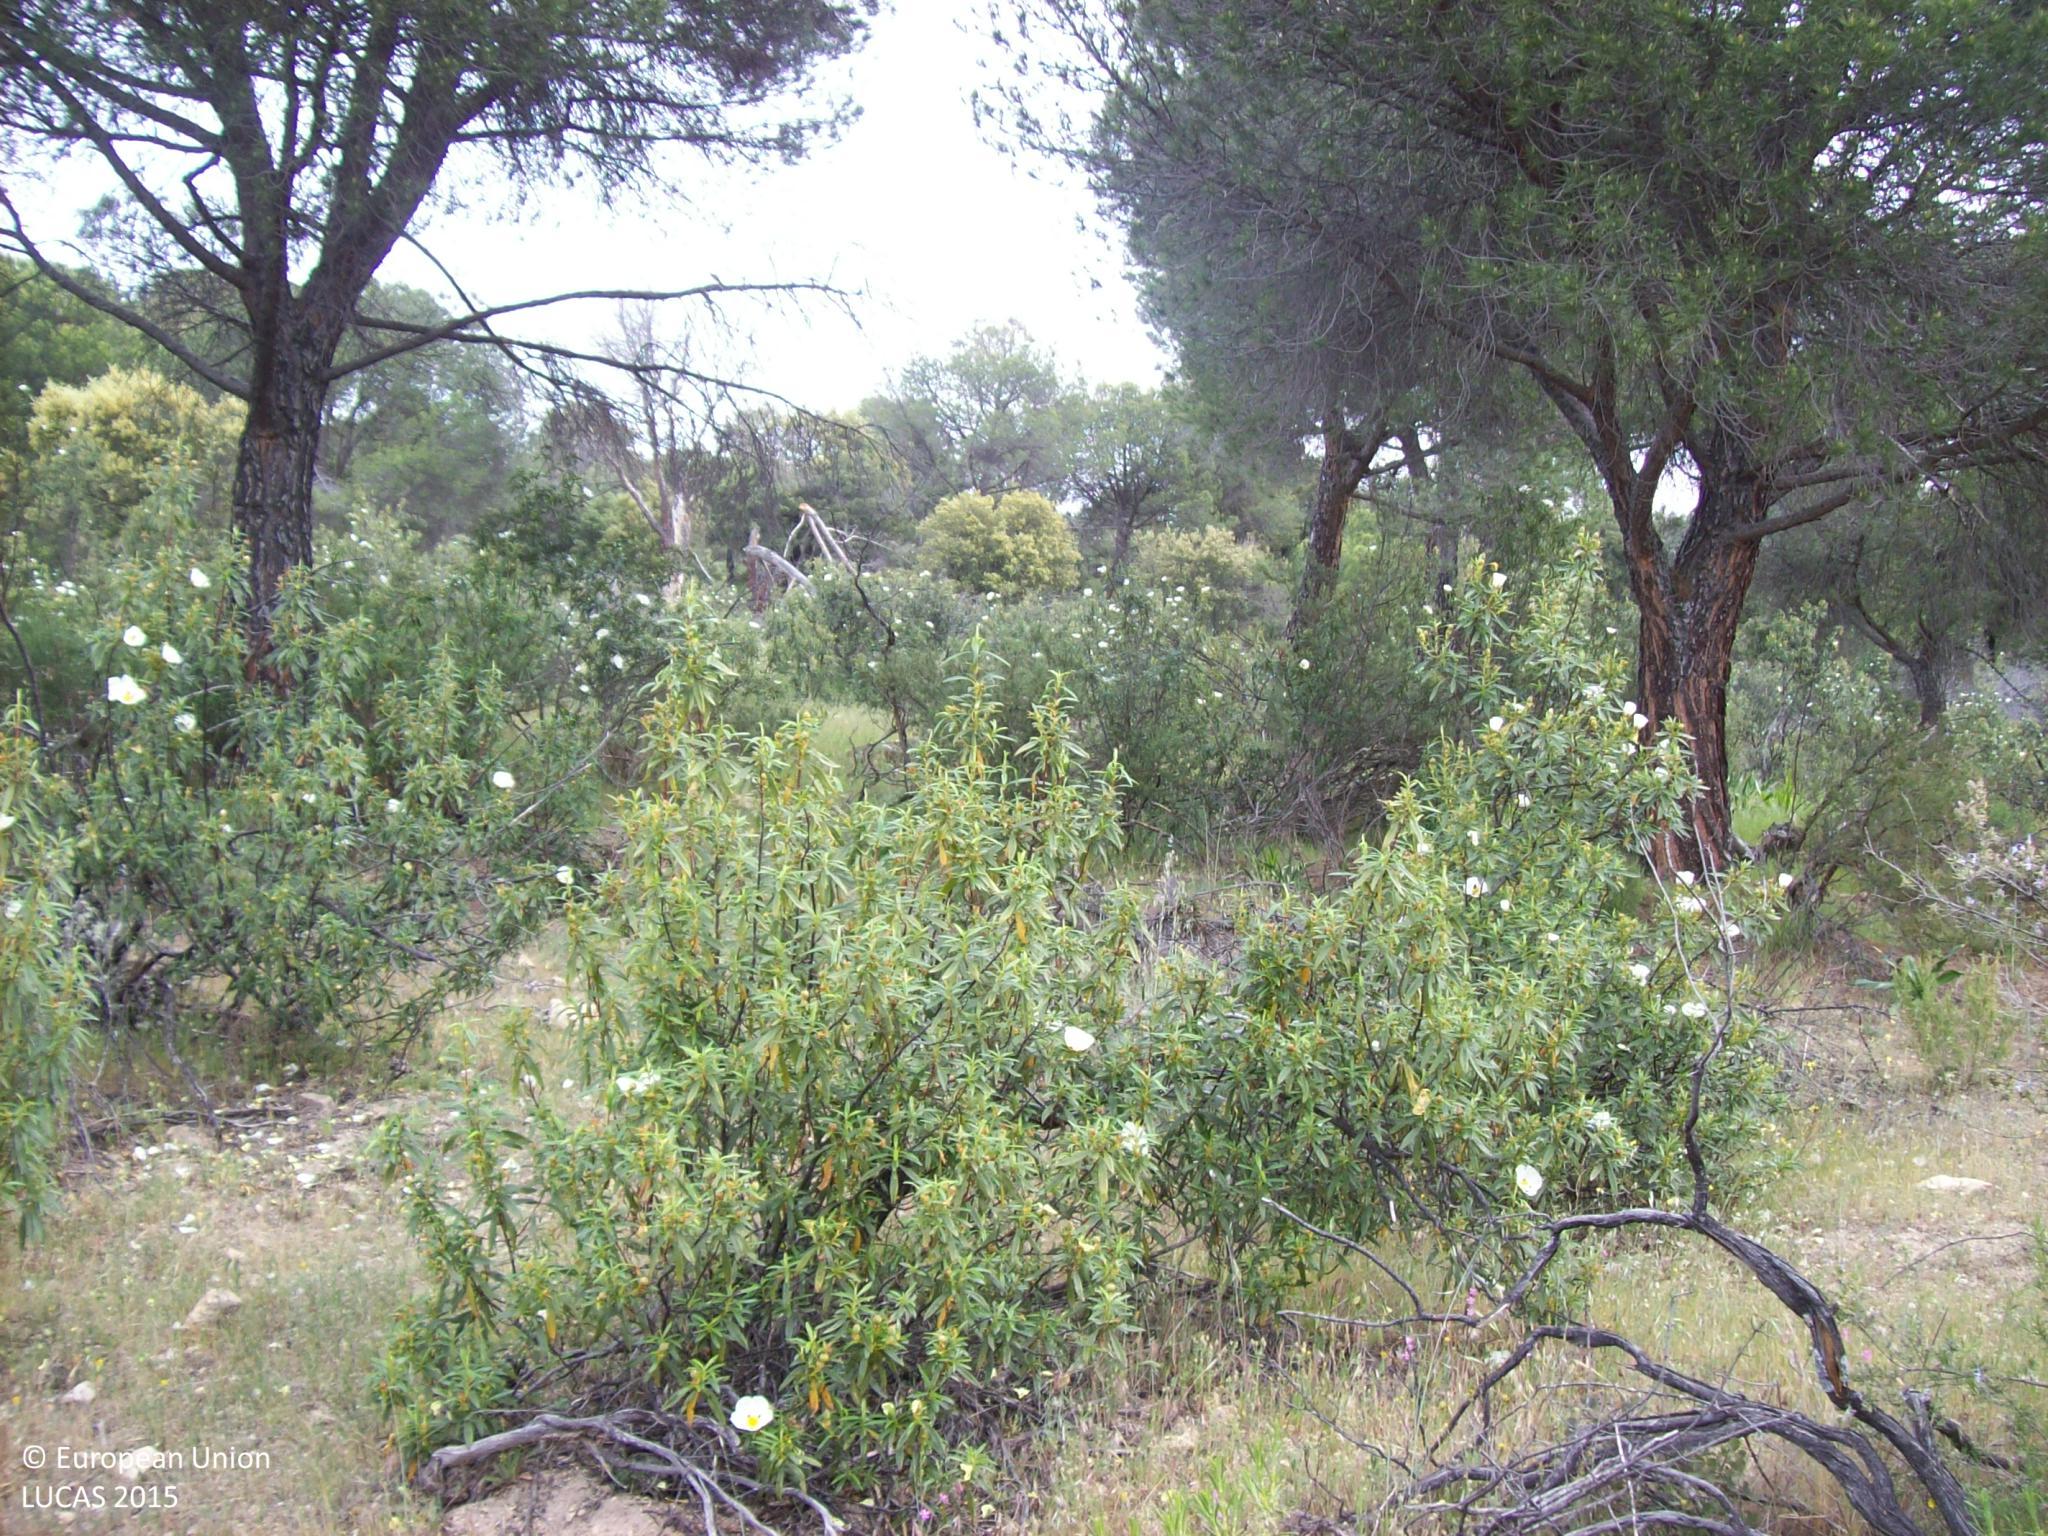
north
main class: Woodland
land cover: Pine dominated coniferous woodland
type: coniferous forest of the mediterranean region
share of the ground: 25 - 50 %
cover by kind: shrubs 40 %, herbaceous plants 35 %, coniferous forest trees 25 %
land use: Sport
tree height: > 5 m
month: April
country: ES
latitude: 40.4288
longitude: -4.3927
